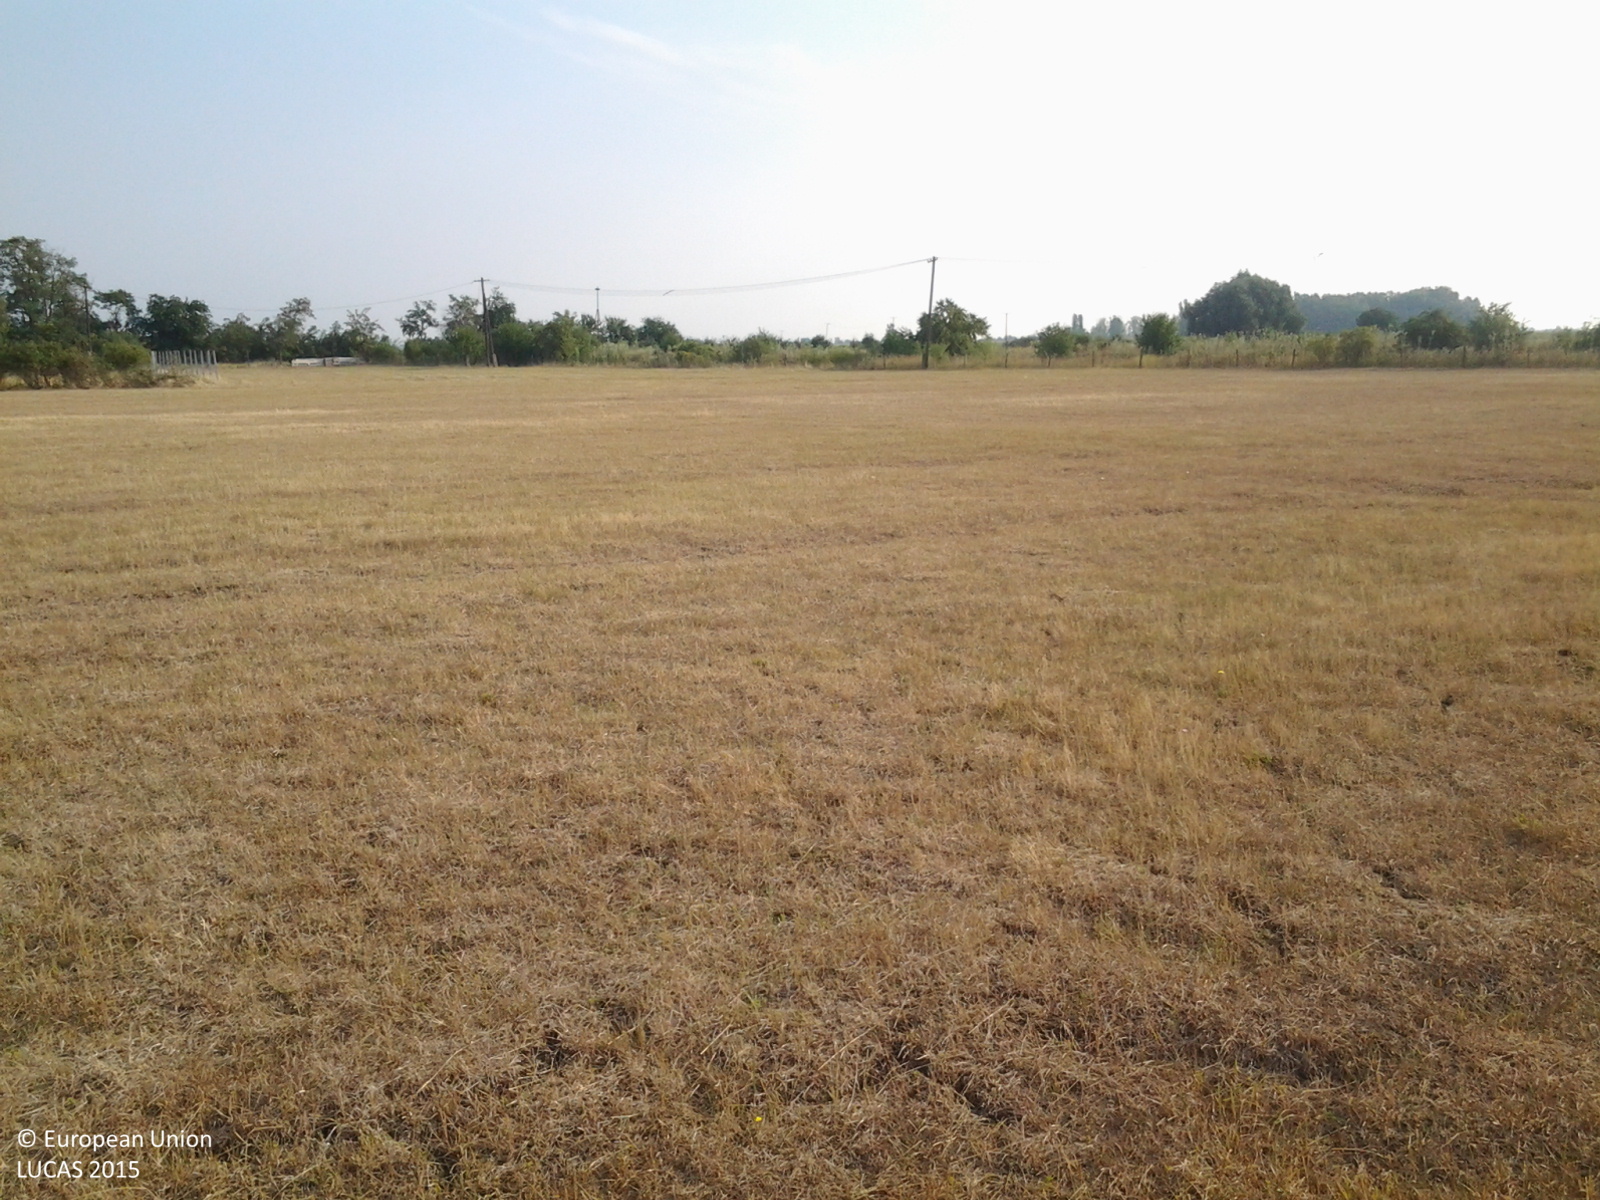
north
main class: Grassland
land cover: Grassland without tree/shrub cover
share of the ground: > 75 %
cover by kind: herbaceous plants 100 %
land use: Agriculture (excluding fallow land and kitchen gardens)
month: July
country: HU
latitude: 46.9785
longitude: 20.6655
